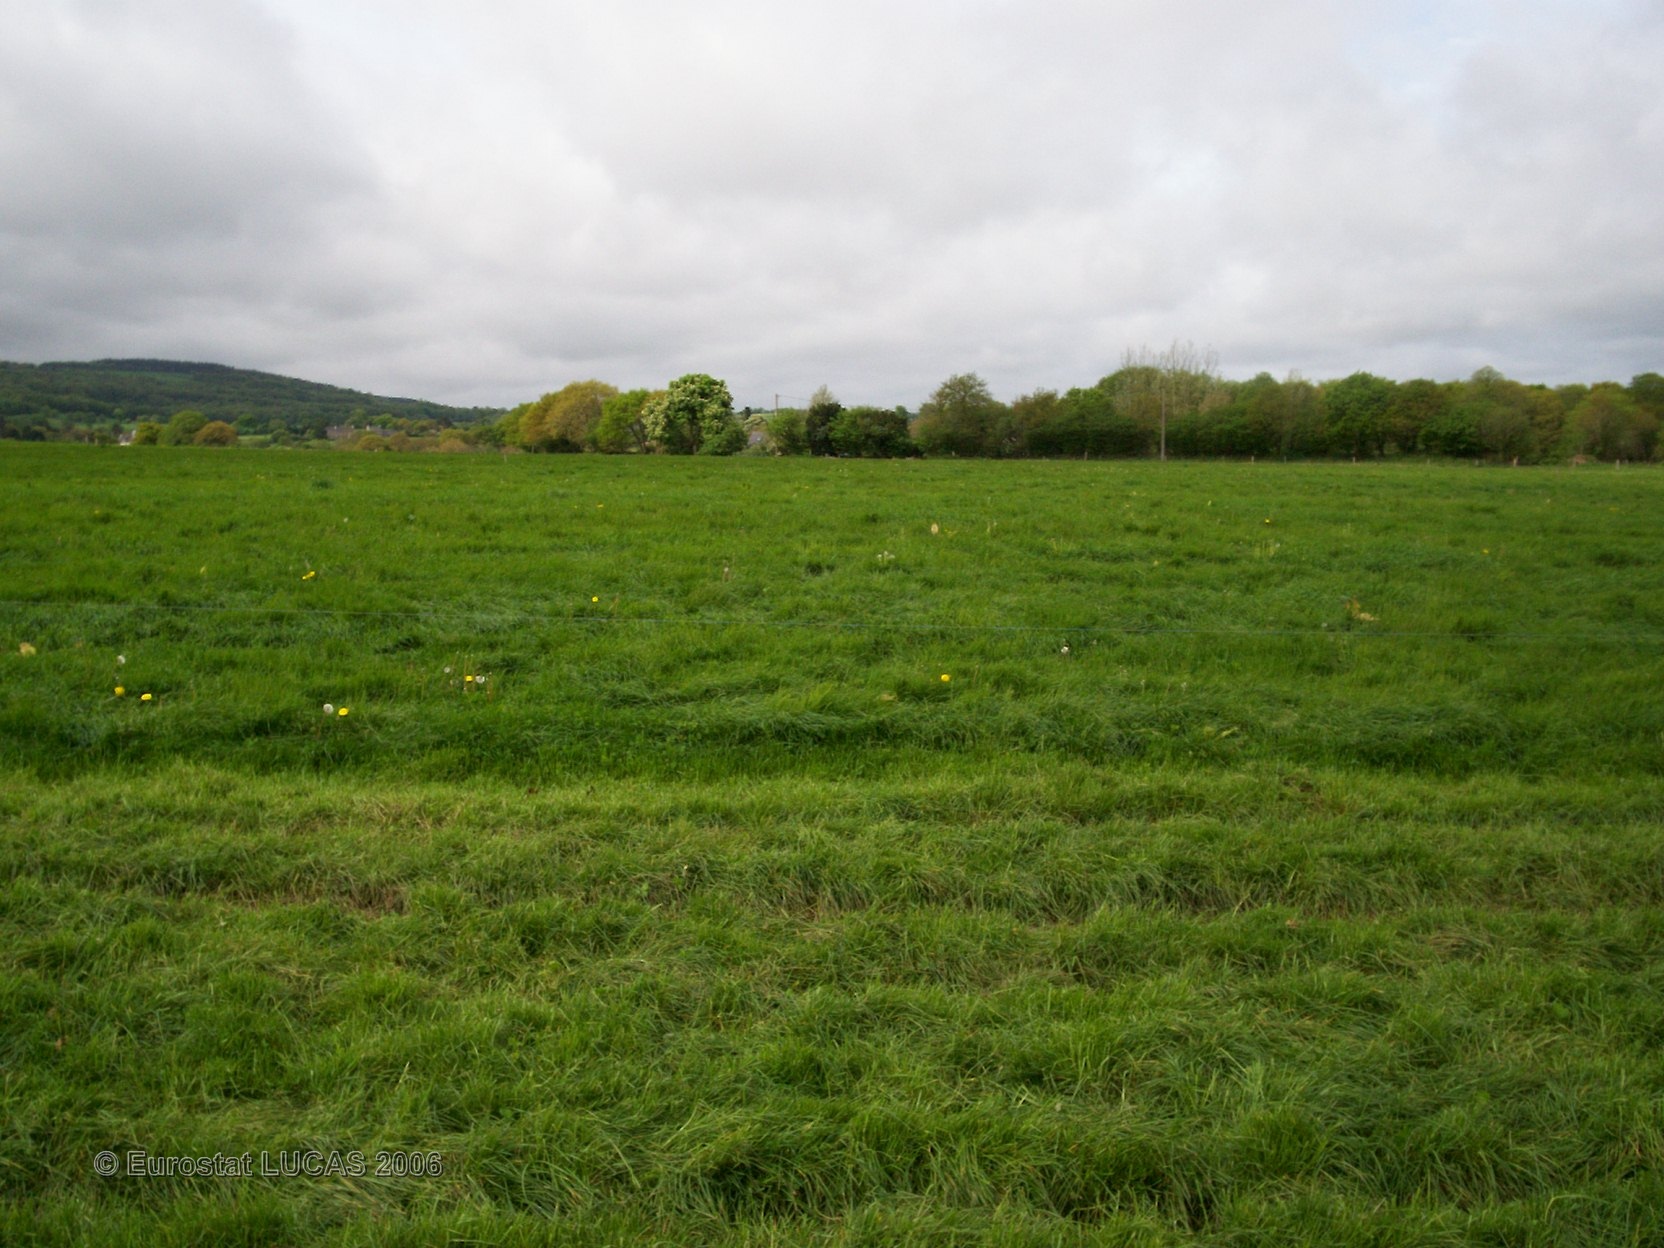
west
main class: Grassland
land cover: Grassland without tree/shrub cover
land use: Agriculture (excluding fallow land and kitchen gardens)
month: May
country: FR
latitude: 48.5110
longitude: -3.7145
